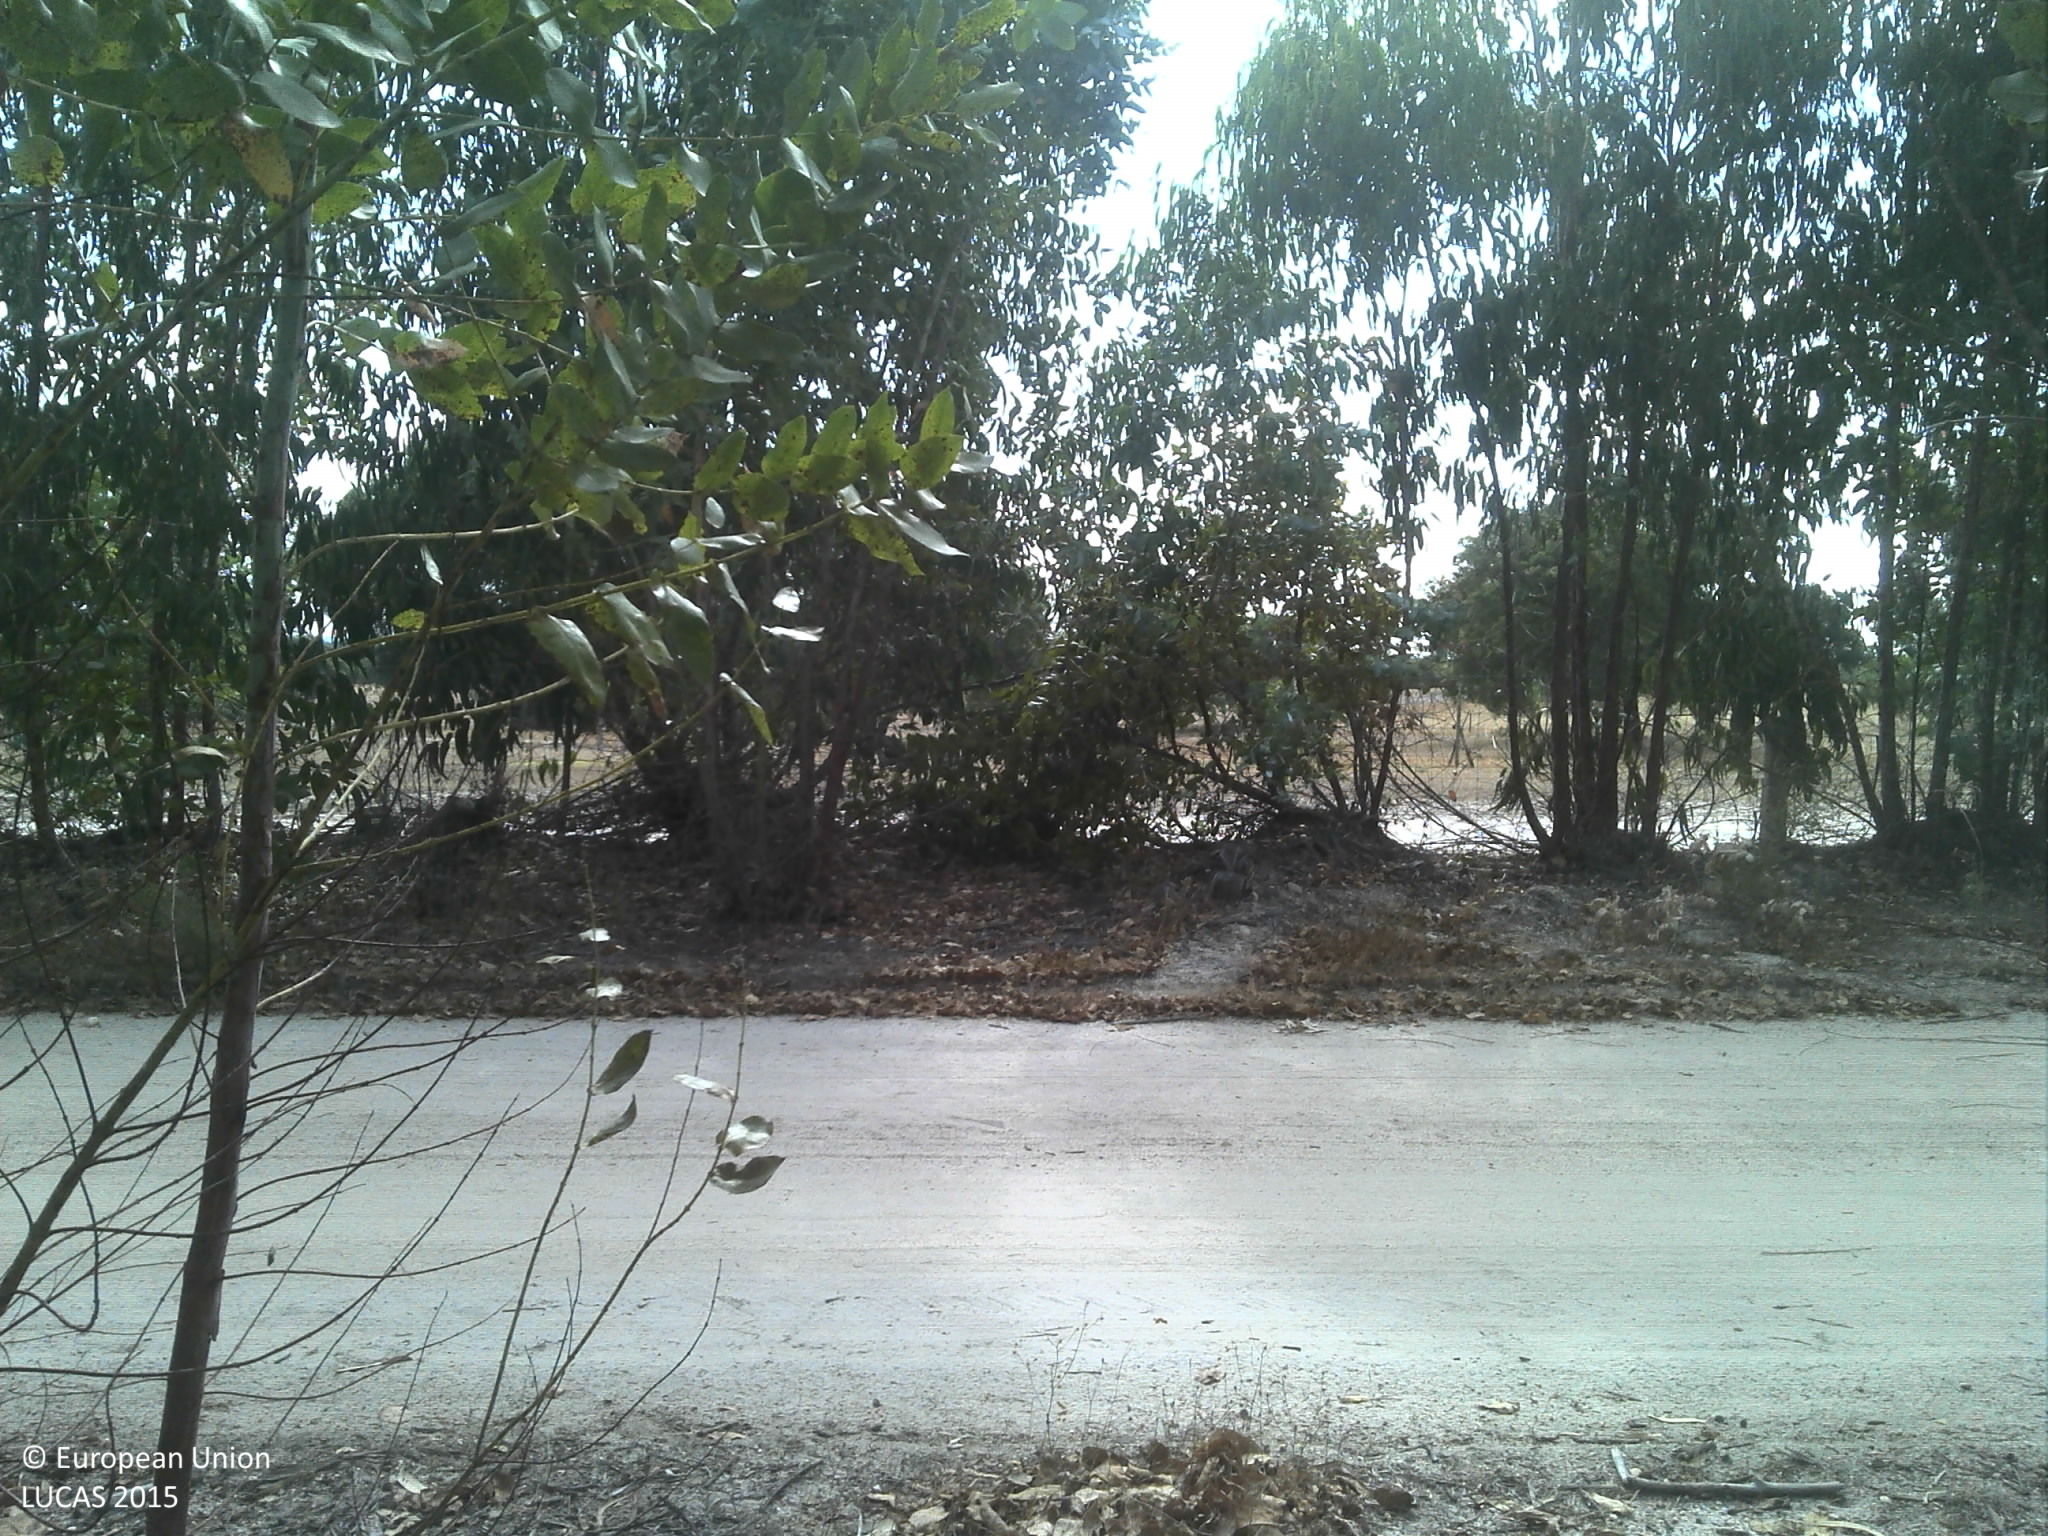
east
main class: Woodland
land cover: Broadleaved woodland
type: broadleaved evergreen forest
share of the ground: 50 - 75 %
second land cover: Grassland without tree/shrub cover
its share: 25 - 50 %
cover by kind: broadleaved forest trees 60 %, herbaceous plants 30 %, unconsolidated bare surface 10 %
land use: Forestry
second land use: Agriculture (excluding fallow land and kitchen gardens)
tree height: > 5 m
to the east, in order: Broadleaved woodland; Grassland without tree/shrub cover; Broadleaved woodland; Other structural elements; Fences; Abandoned hedges; Shruby margins; Tracks; Fences; Other structural elements; Grassland without tree/shrub cover; Other bare soil; Fences; Broadleaved woodland
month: July
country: PT
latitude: 38.9200
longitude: -8.6698
